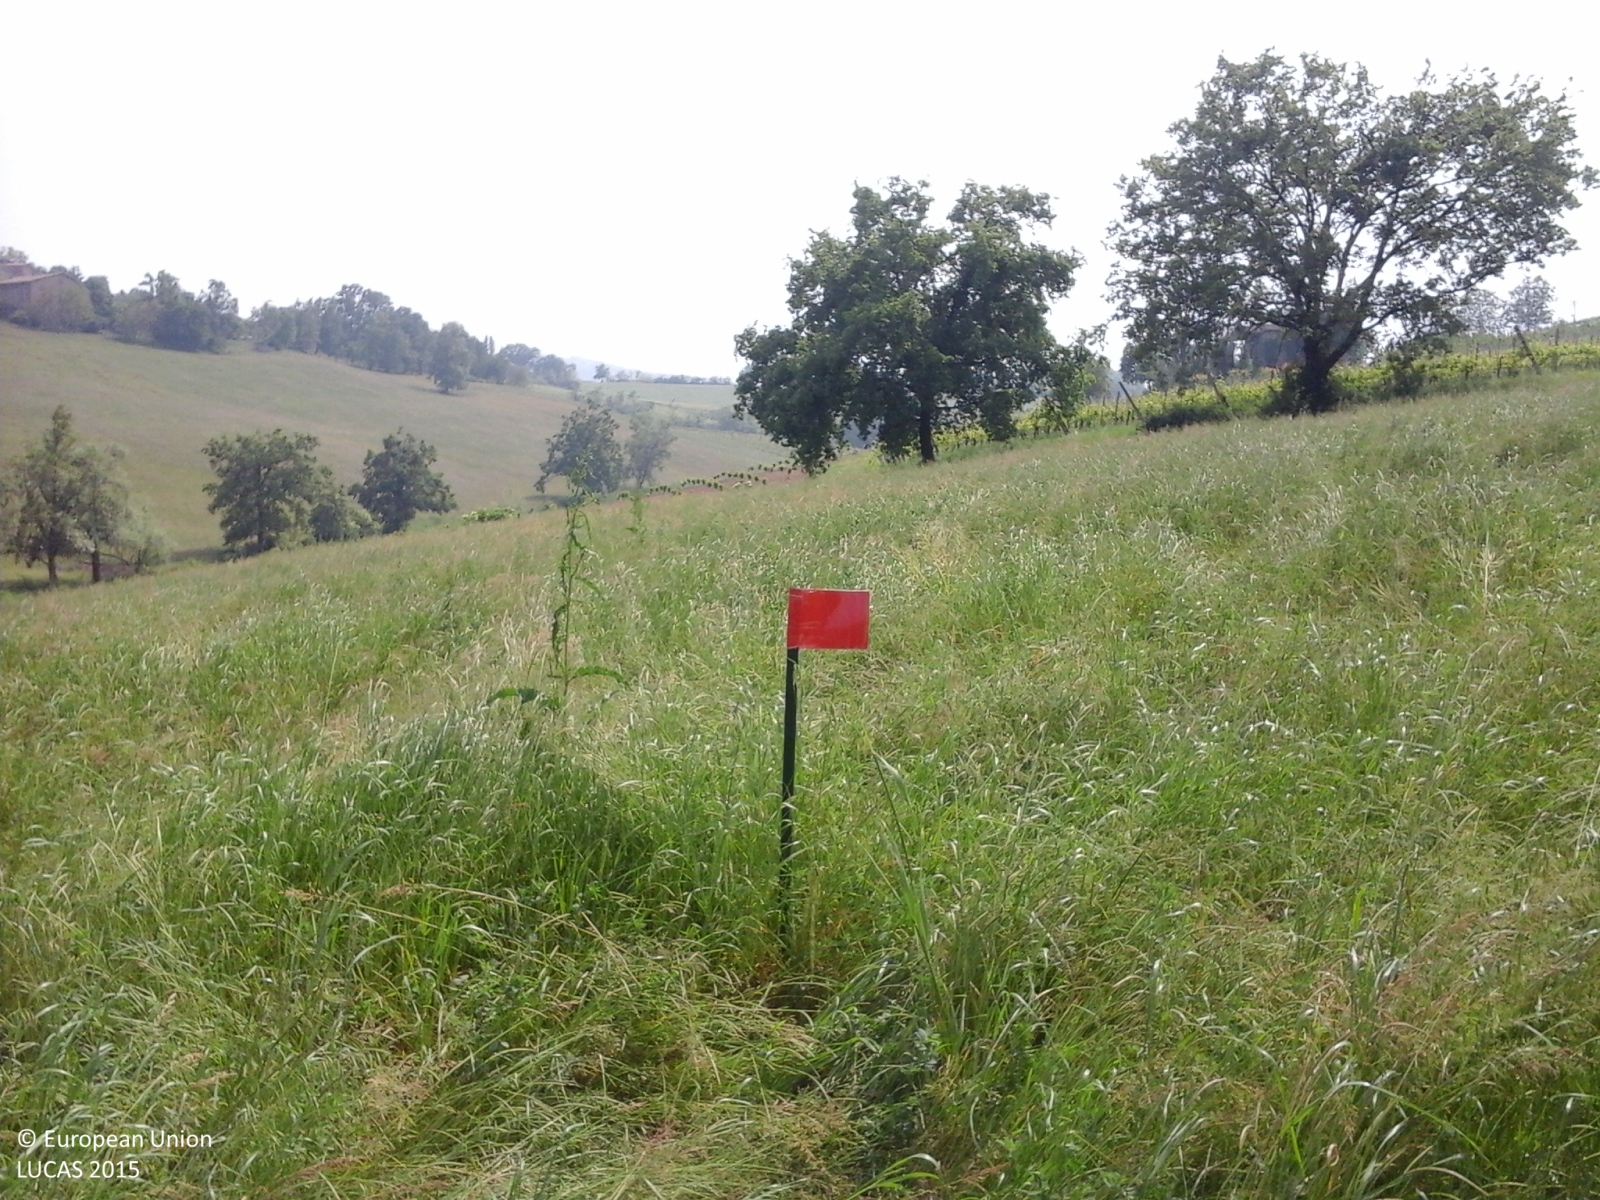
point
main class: Cropland
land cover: Lucerne
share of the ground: > 75 %
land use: Agriculture (excluding fallow land and kitchen gardens)
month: May
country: IT
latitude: 44.4908
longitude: 10.9159
